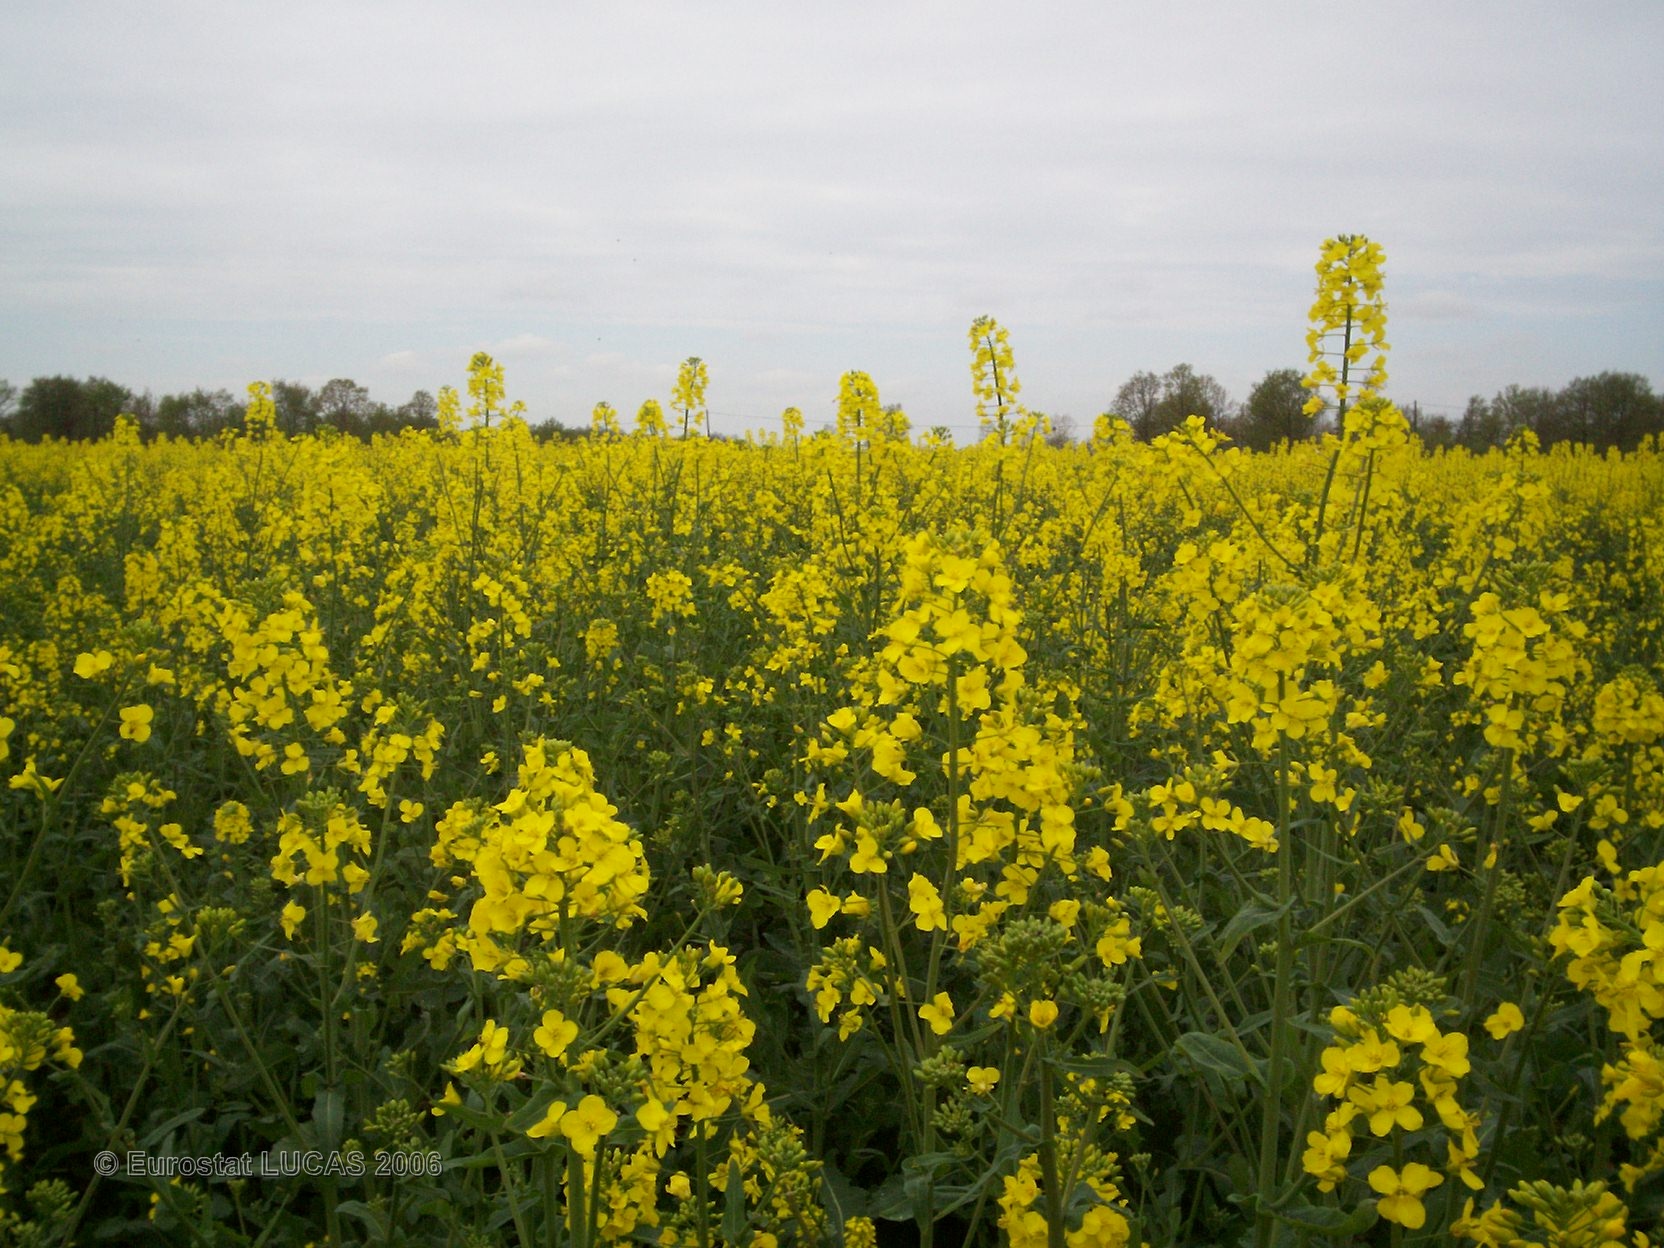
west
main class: Cropland
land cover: Rape and turnip rape
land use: Agriculture (excluding fallow land and kitchen gardens)
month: May
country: FR
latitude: 48.8724
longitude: 0.6088
